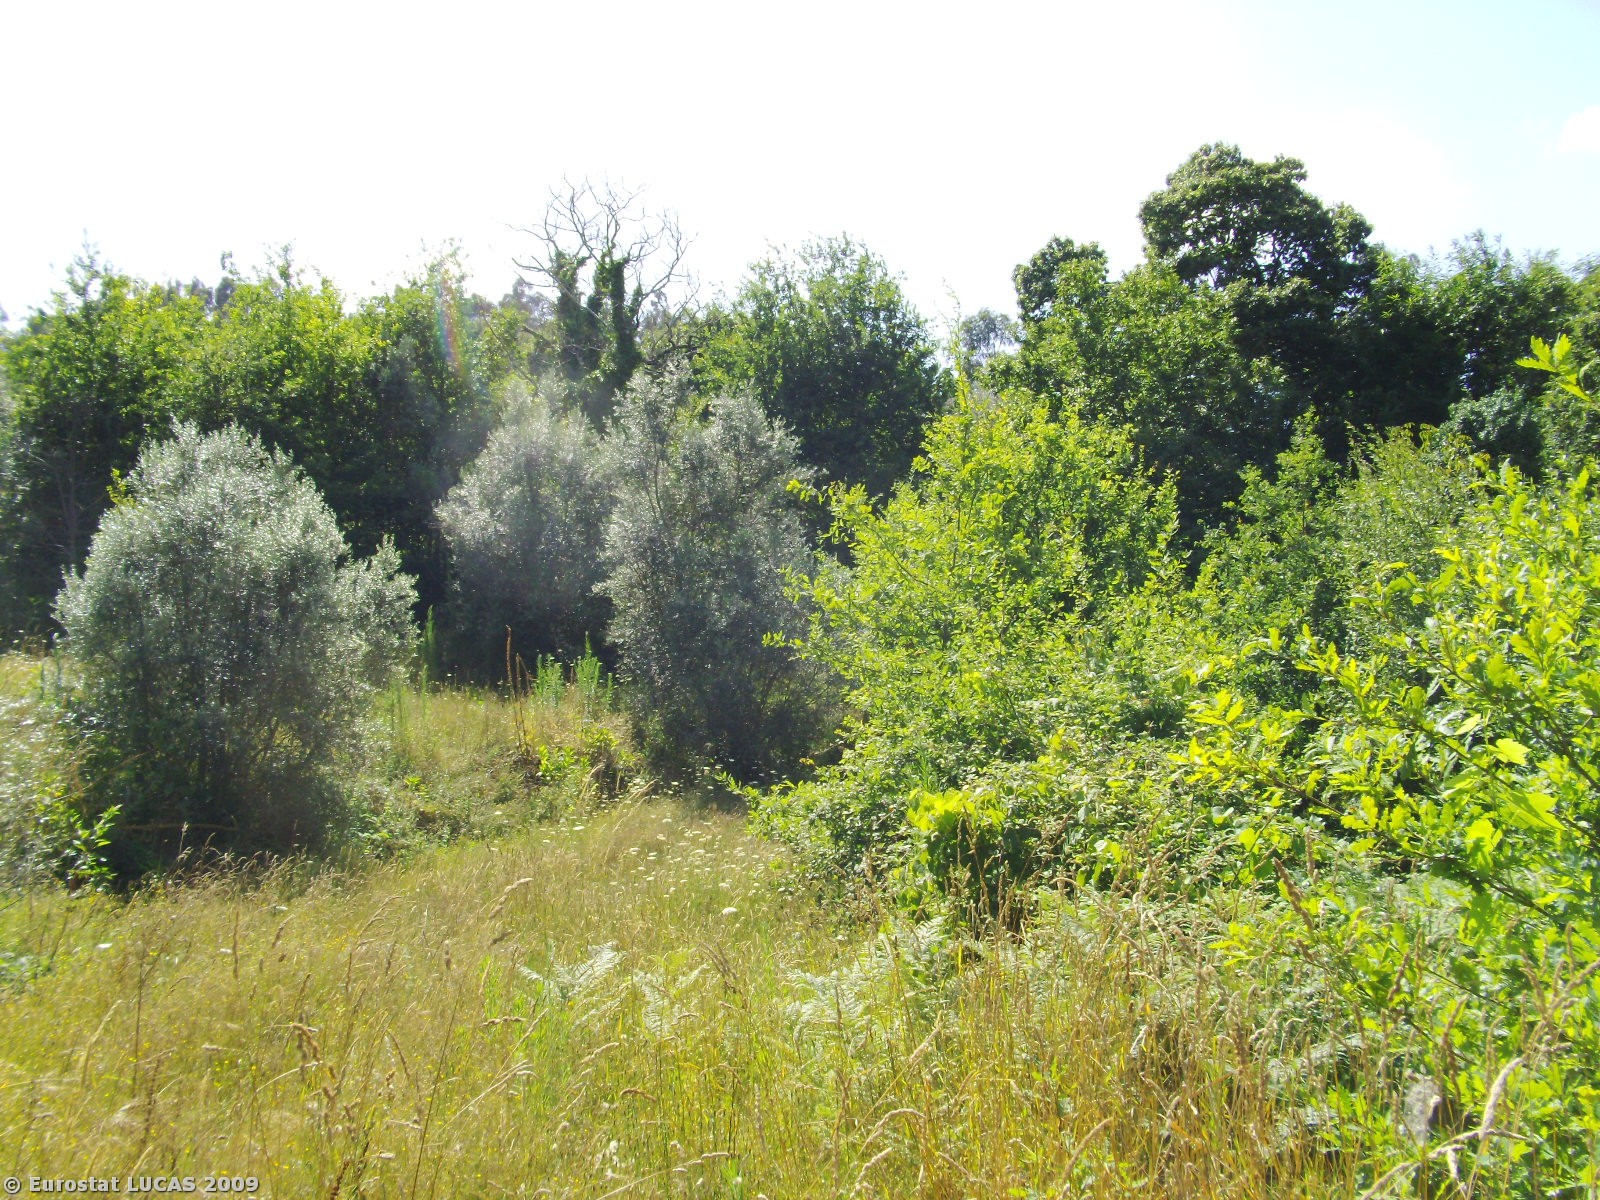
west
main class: Grassland
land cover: Spontaneously vegetated surfaces
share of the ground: > 75 %
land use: Fallow land
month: July
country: PT
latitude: 41.7151
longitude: -8.5622
